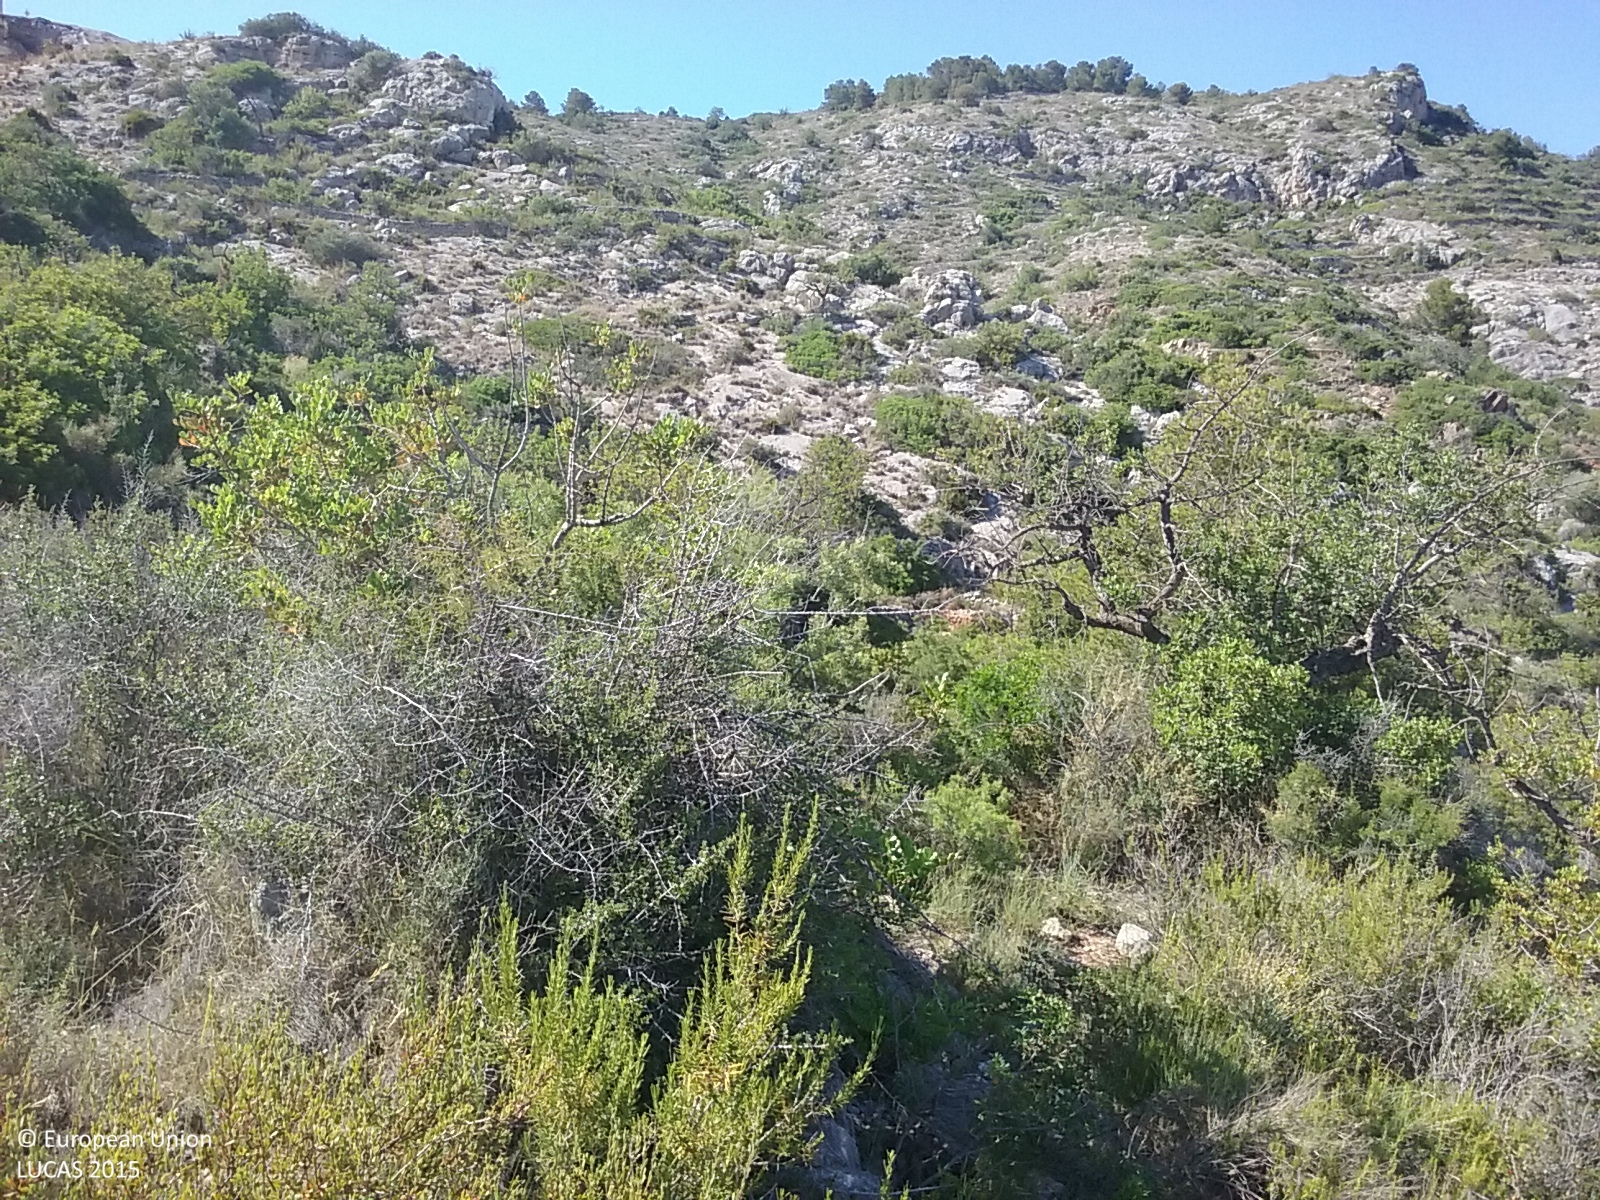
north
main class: Cropland
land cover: Permanent industrial crops
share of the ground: < 10 %
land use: Abandoned areas
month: June
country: ES
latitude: 40.0240
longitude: -0.0432
